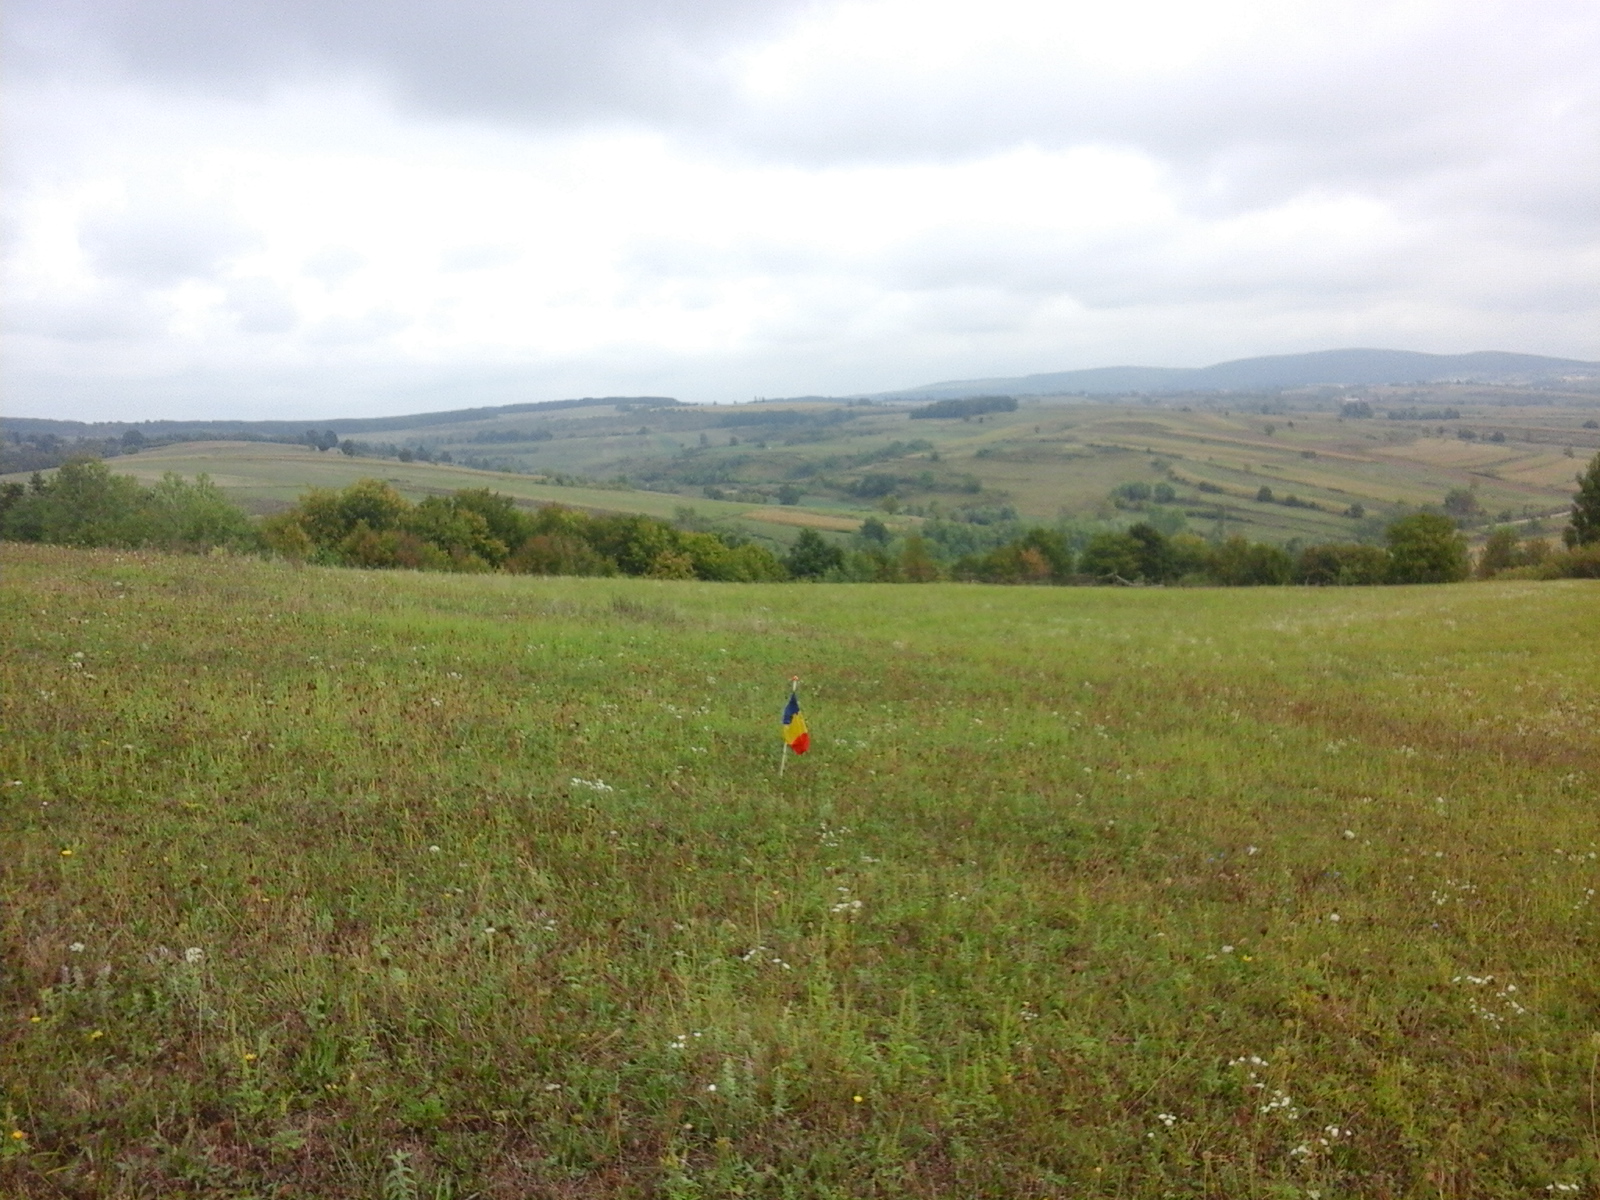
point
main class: Grassland
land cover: Grassland without tree/shrub cover
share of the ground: > 75 %
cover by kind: herbaceous plants 100 %
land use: Agriculture (excluding fallow land and kitchen gardens)
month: September
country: RO
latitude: 46.6911
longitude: 22.1693
